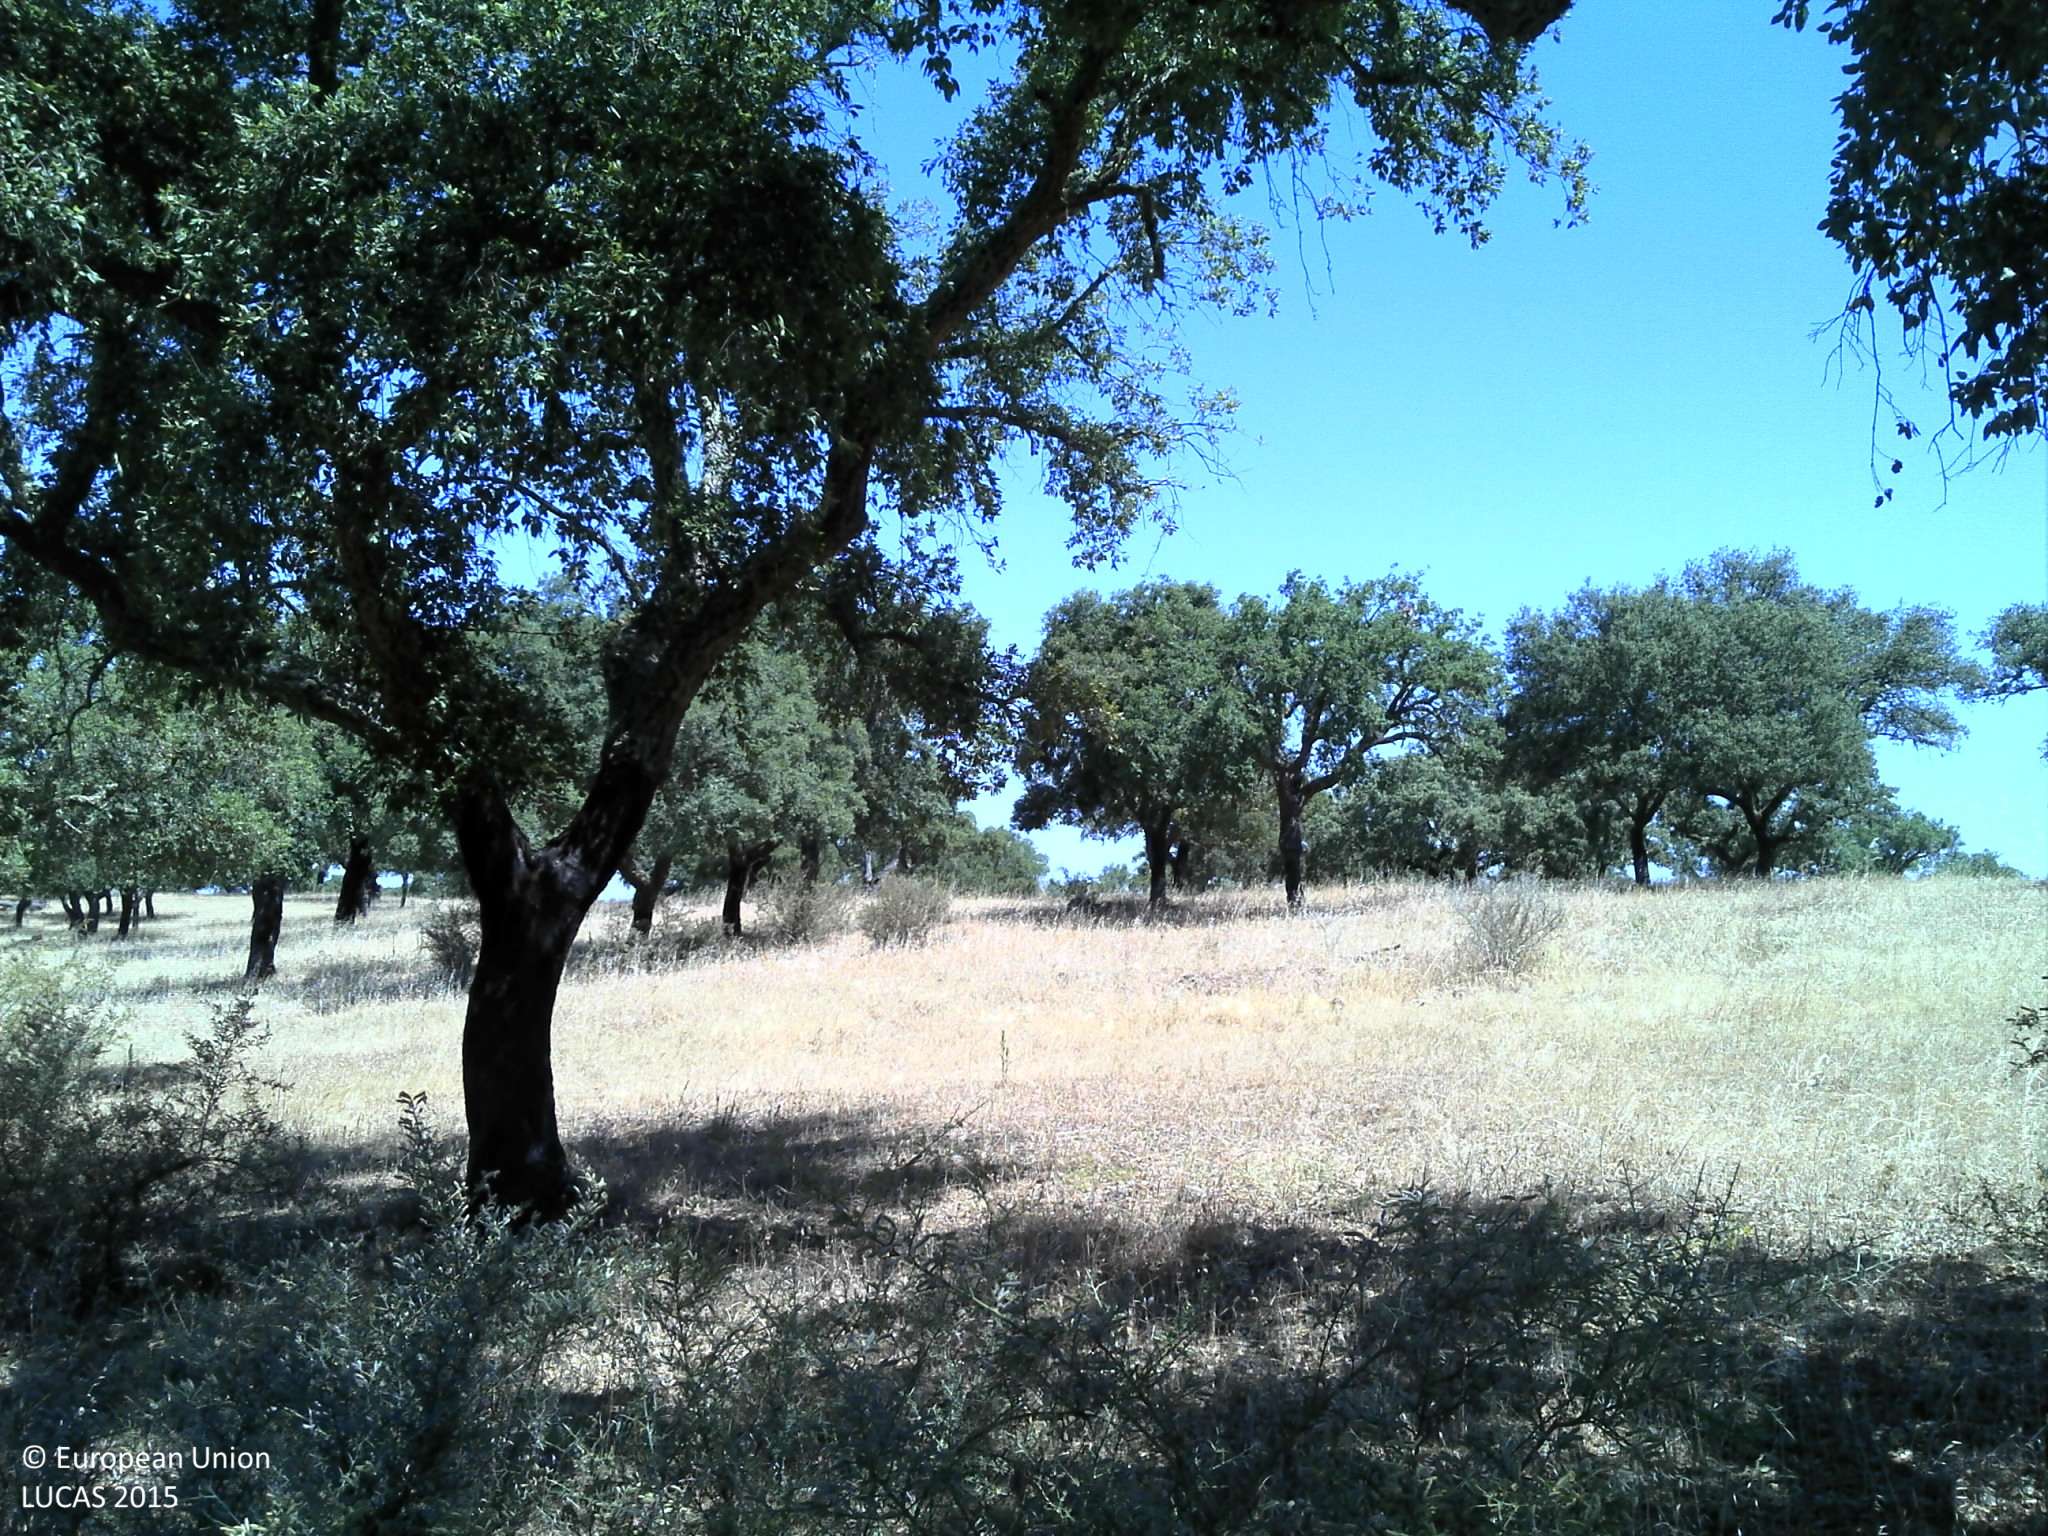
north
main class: Woodland
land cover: Broadleaved woodland
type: broadleaved evergreen forest
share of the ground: 50 - 75 %
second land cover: Grassland without tree/shrub cover
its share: 50 - 75 %
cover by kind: broadleaved forest trees 50 %, herbaceous plants 40 %, unconsolidated bare surface 10 %
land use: Forestry
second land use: Agriculture (excluding fallow land and kitchen gardens)
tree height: > 5 m
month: June
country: PT
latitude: 38.7683
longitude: -7.8229
